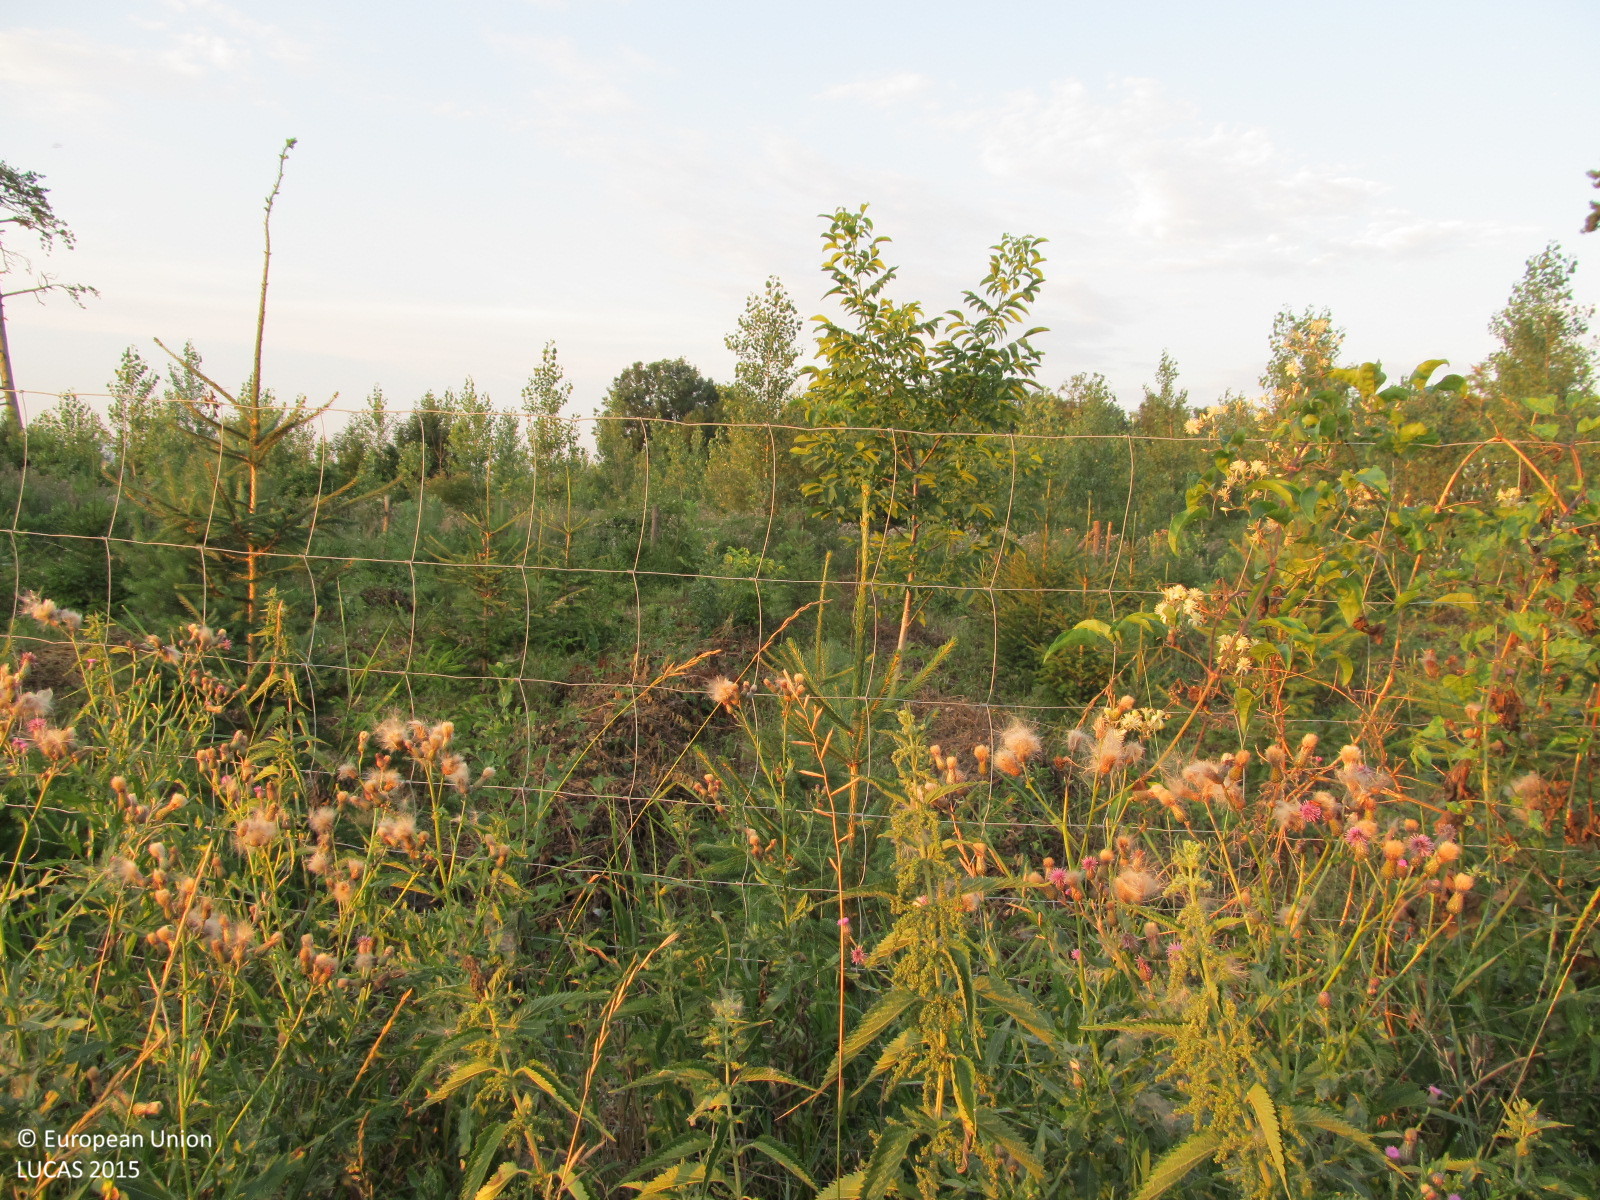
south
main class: Shrubland
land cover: Shrubland with sparse tree cover
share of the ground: > 75 %
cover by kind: shrubs 85 %, coniferous forest trees 5 %, herbaceous plants 5 %, unconsolidated bare surface 5 %
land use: Forestry
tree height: < 5 m
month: July
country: AT
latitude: 48.1956
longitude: 15.4778
